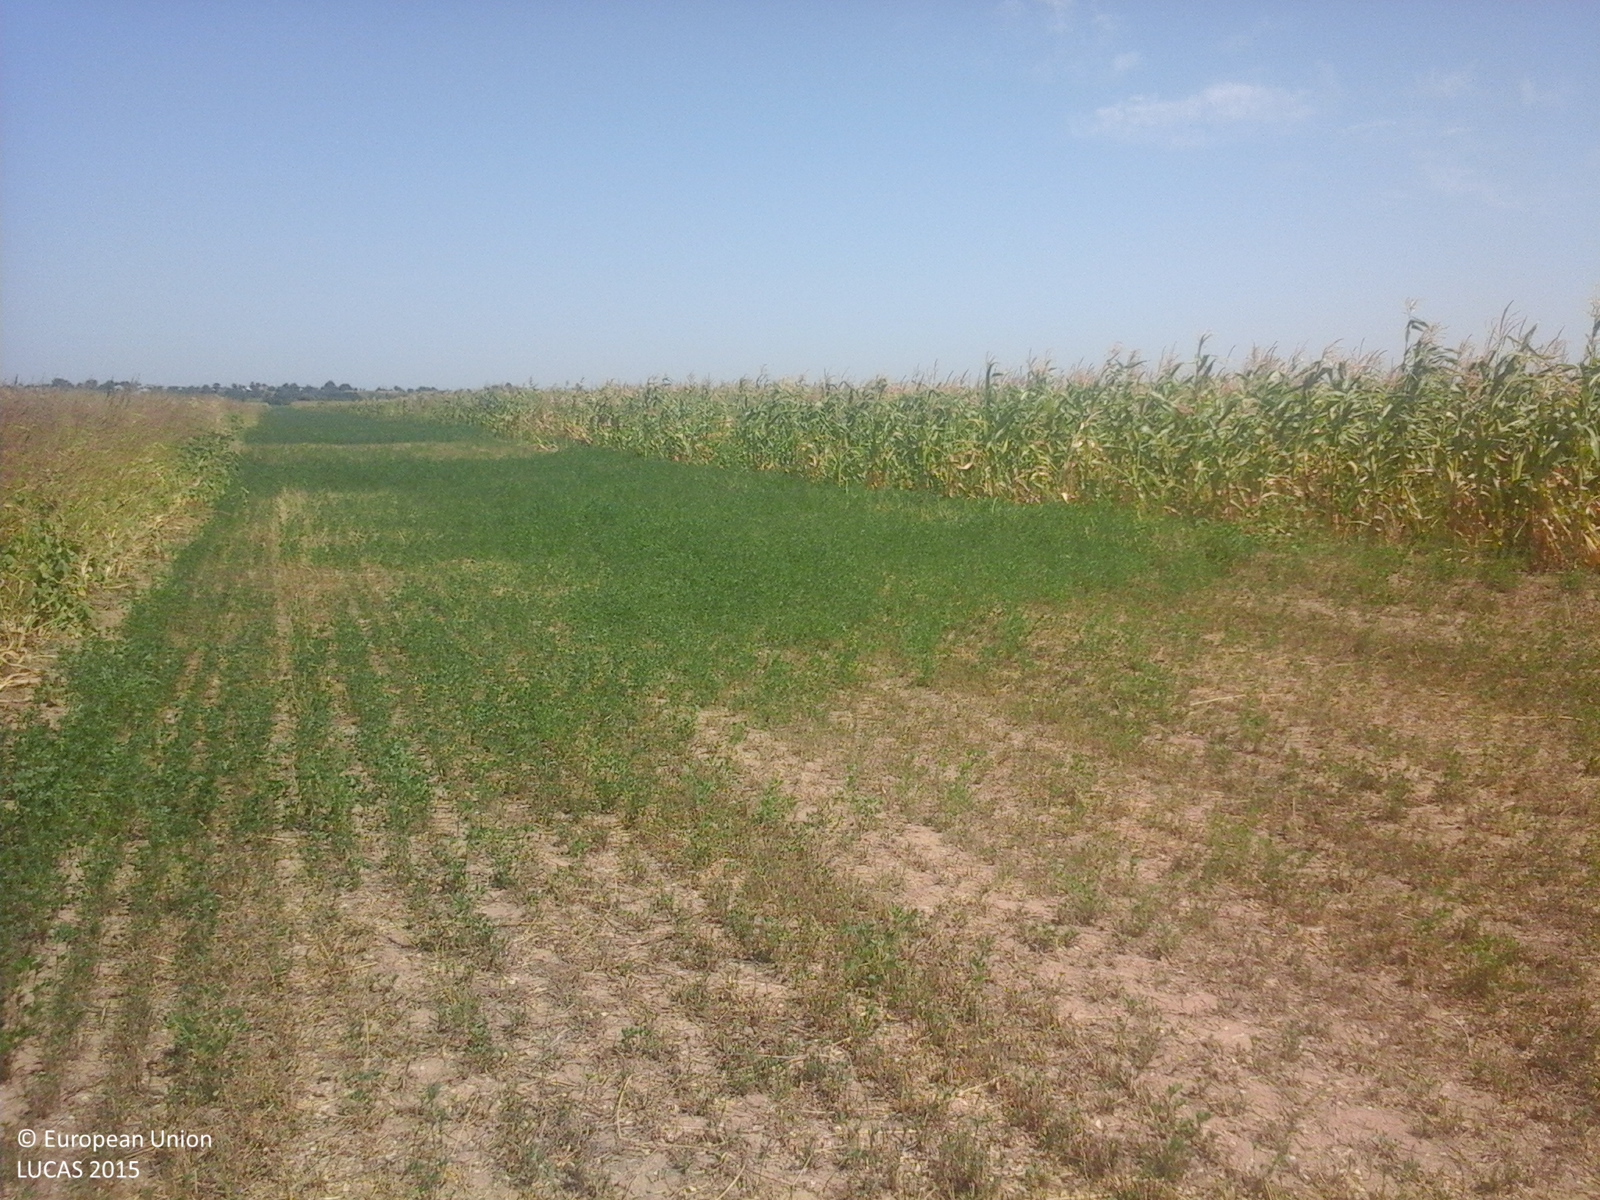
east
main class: Cropland
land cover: Lucerne
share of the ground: 50 - 75 %
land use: Agriculture (excluding fallow land and kitchen gardens)
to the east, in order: Lucerne; Maize
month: August
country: RO
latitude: 45.8244
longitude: 27.4417
